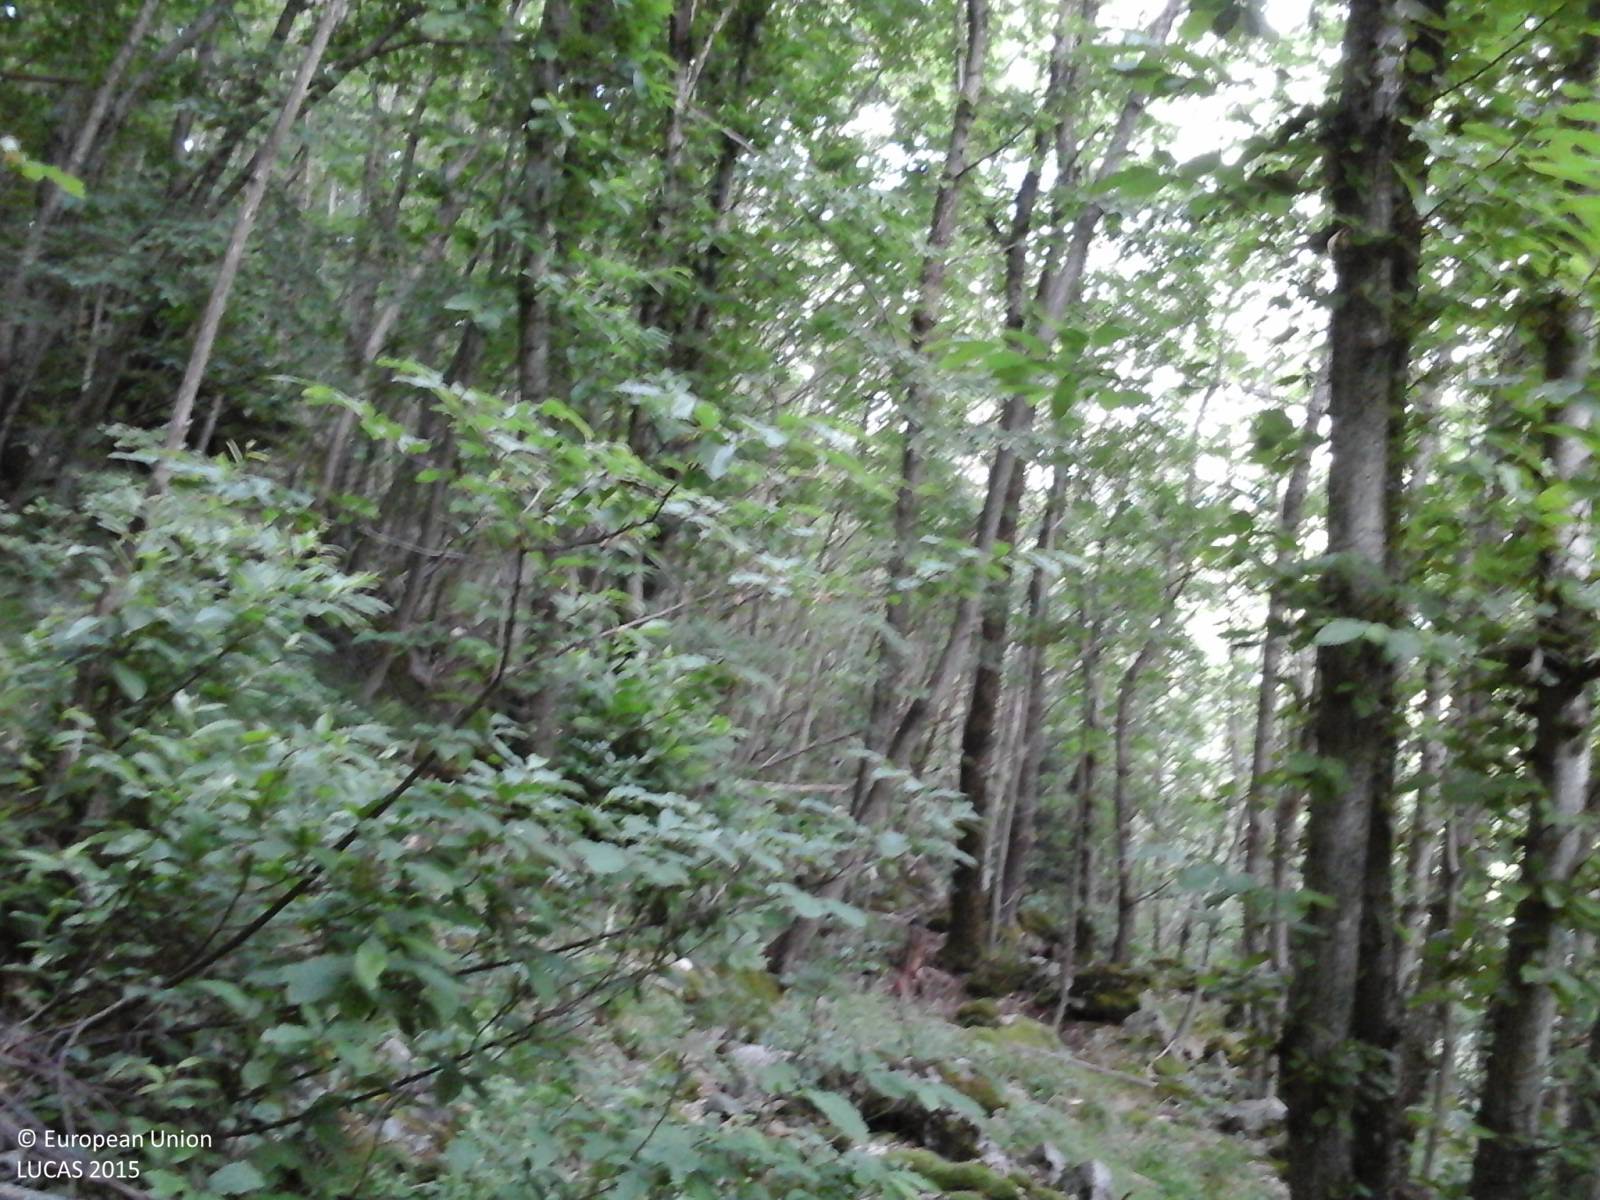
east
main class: Woodland
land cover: Broadleaved woodland
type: thermophilous deciduous forest
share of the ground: > 75 %
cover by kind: broadleaved forest trees 75 %, shrubs 25 %
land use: Forestry
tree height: > 5 m
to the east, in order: Broadleaved woodland; Dry stone walls; Tracks; Broadleaved woodland; Rivers and streams; Broadleaved woodland
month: June
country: IT
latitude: 44.1317
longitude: 10.7107
